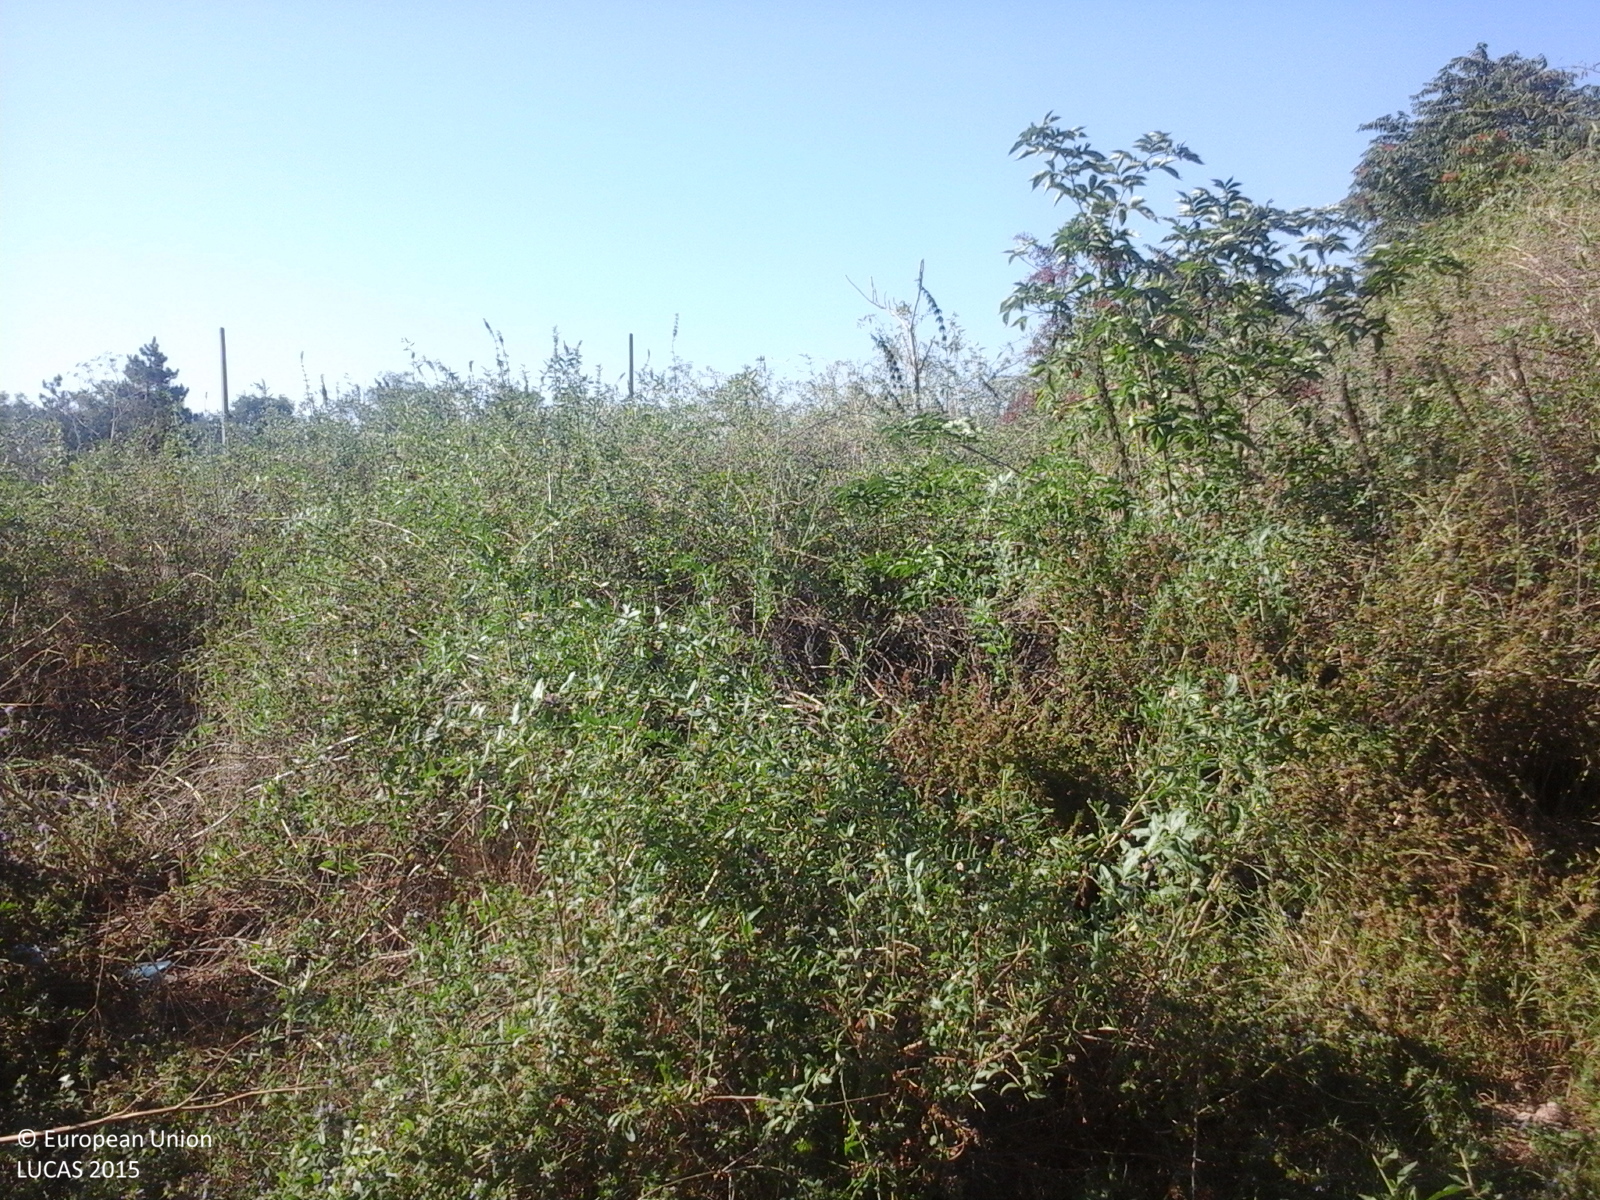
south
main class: Cropland
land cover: Maize
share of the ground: > 75 %
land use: Agriculture (excluding fallow land and kitchen gardens)
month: August
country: RO
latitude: 44.6377
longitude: 28.1280
